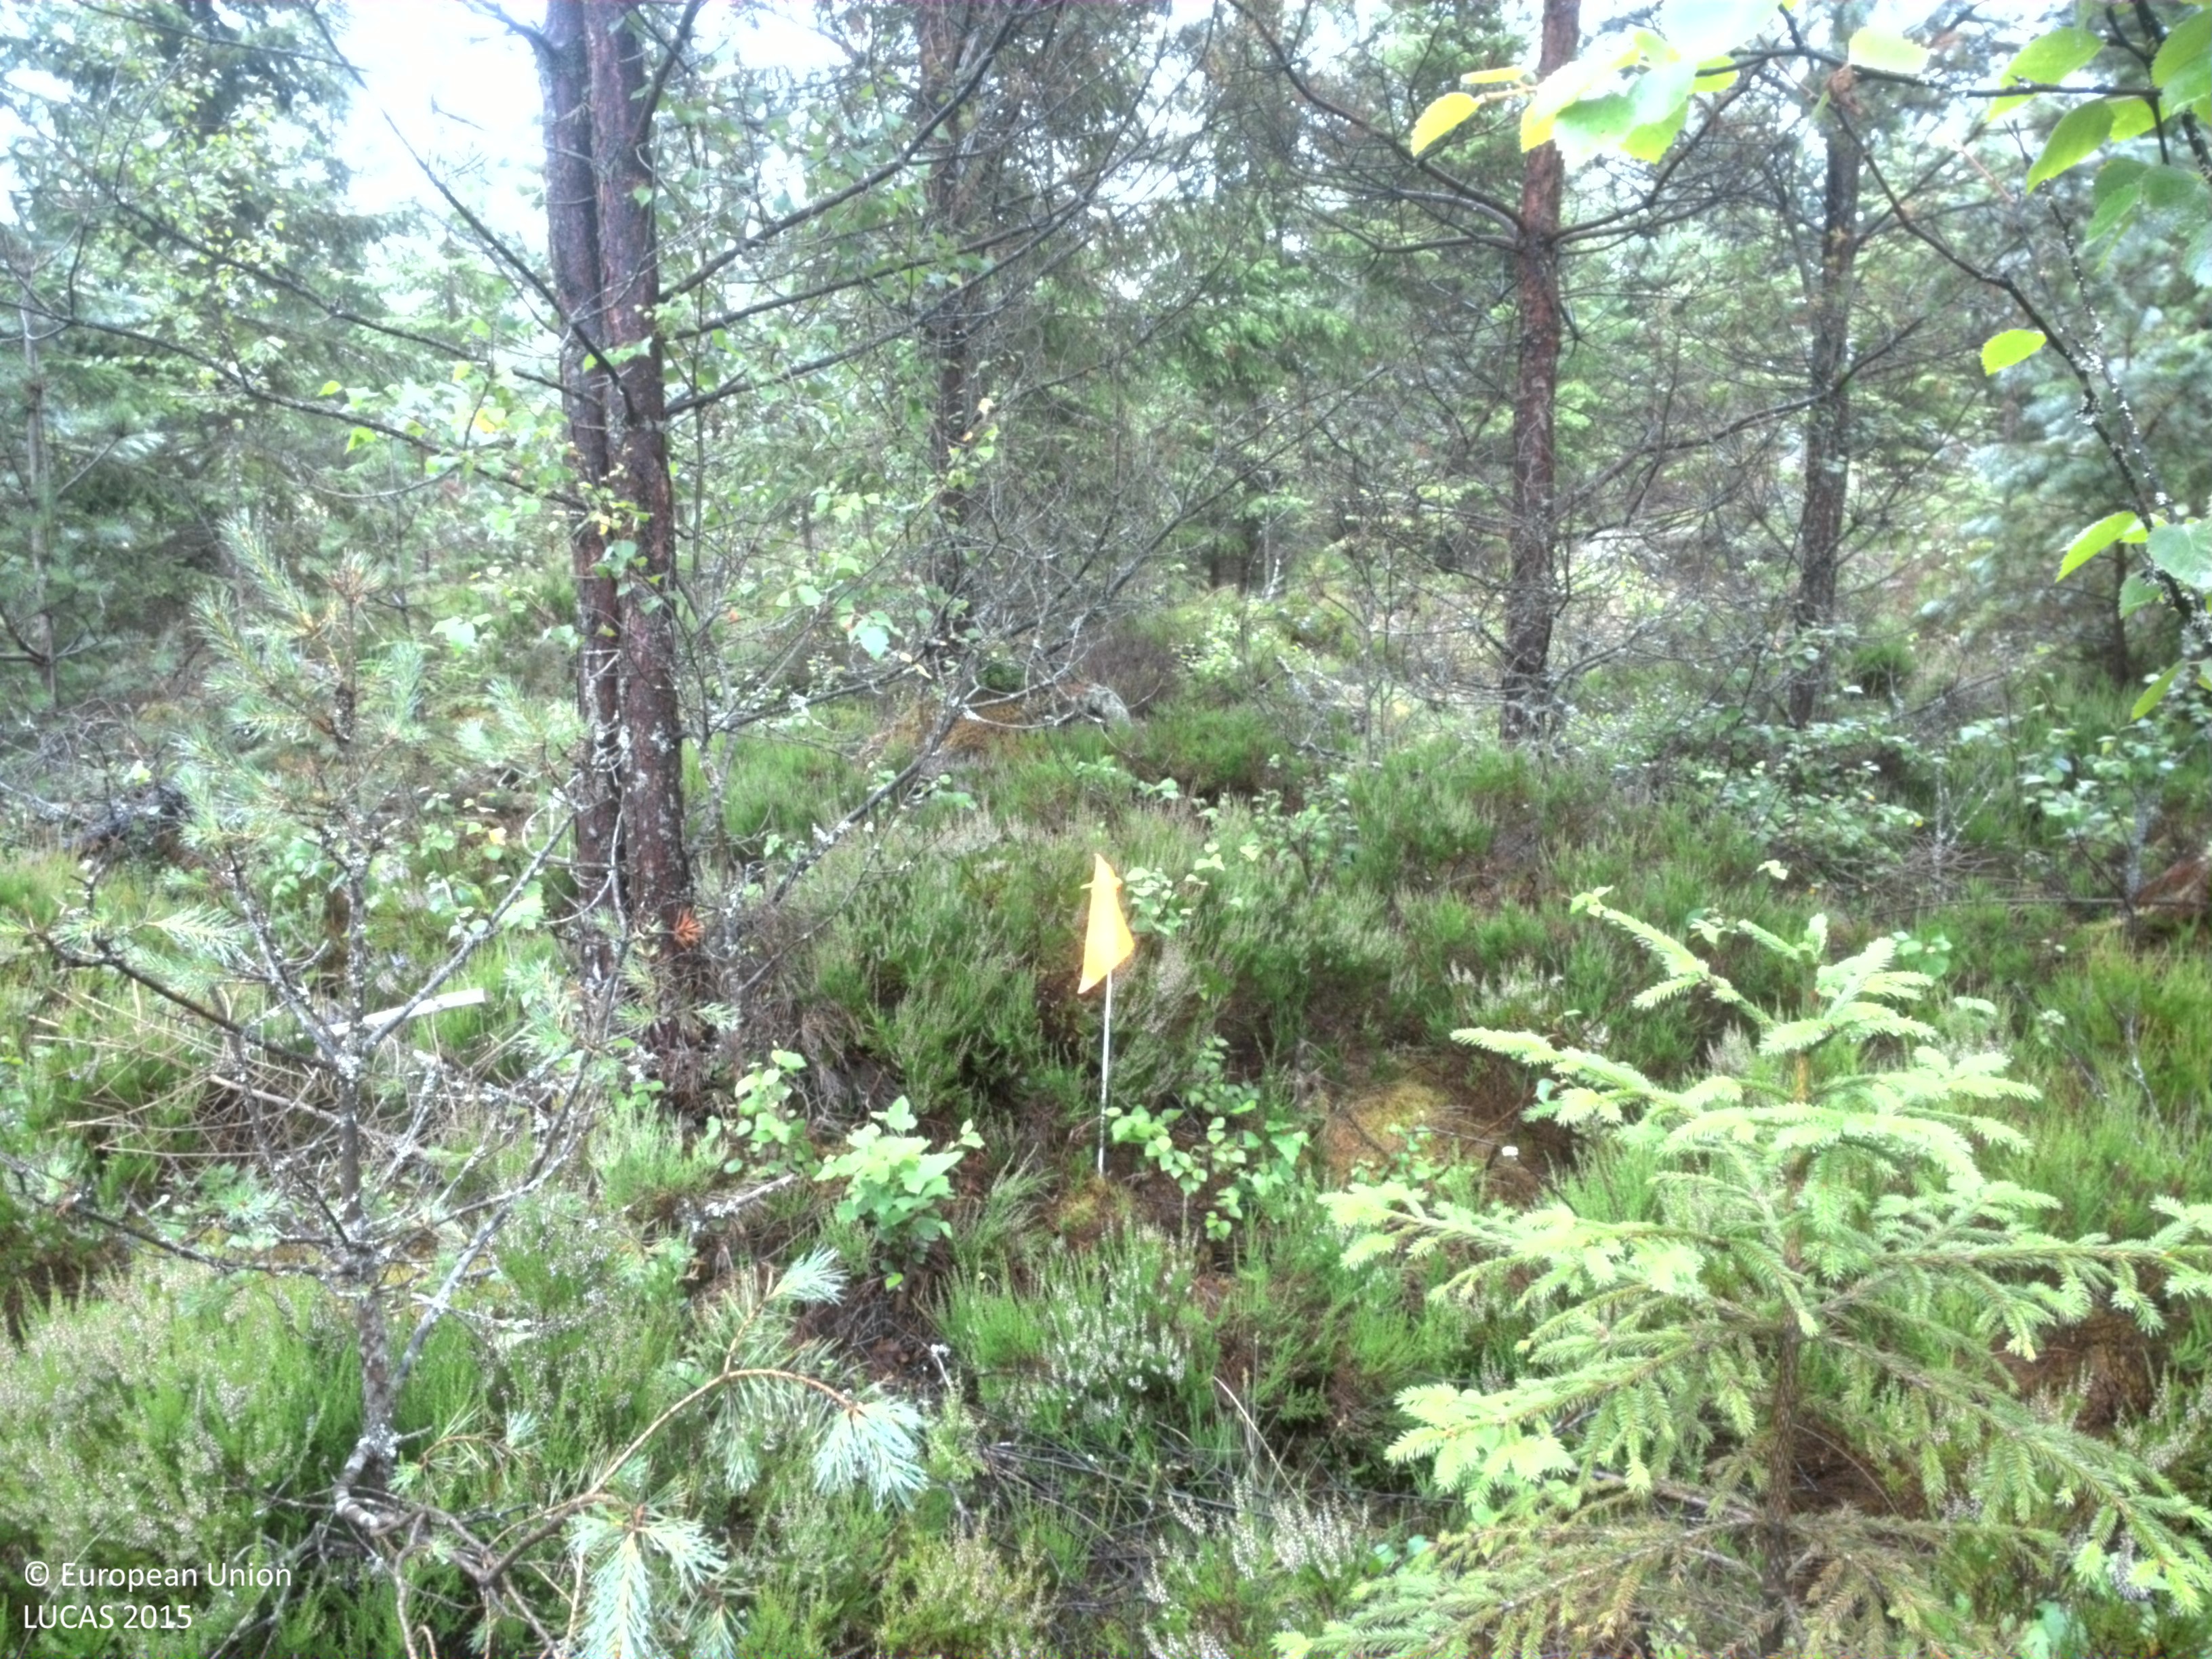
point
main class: Woodland
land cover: Other coniferous woodland
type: boreal forest
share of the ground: > 75 %
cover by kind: coniferous forest trees 70 %, broadleaved forest trees 10 %, shrubs 10 %, lichens and mosses 10 %
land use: Forestry
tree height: > 5 m
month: July
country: SE
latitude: 59.2558
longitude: 14.6741
